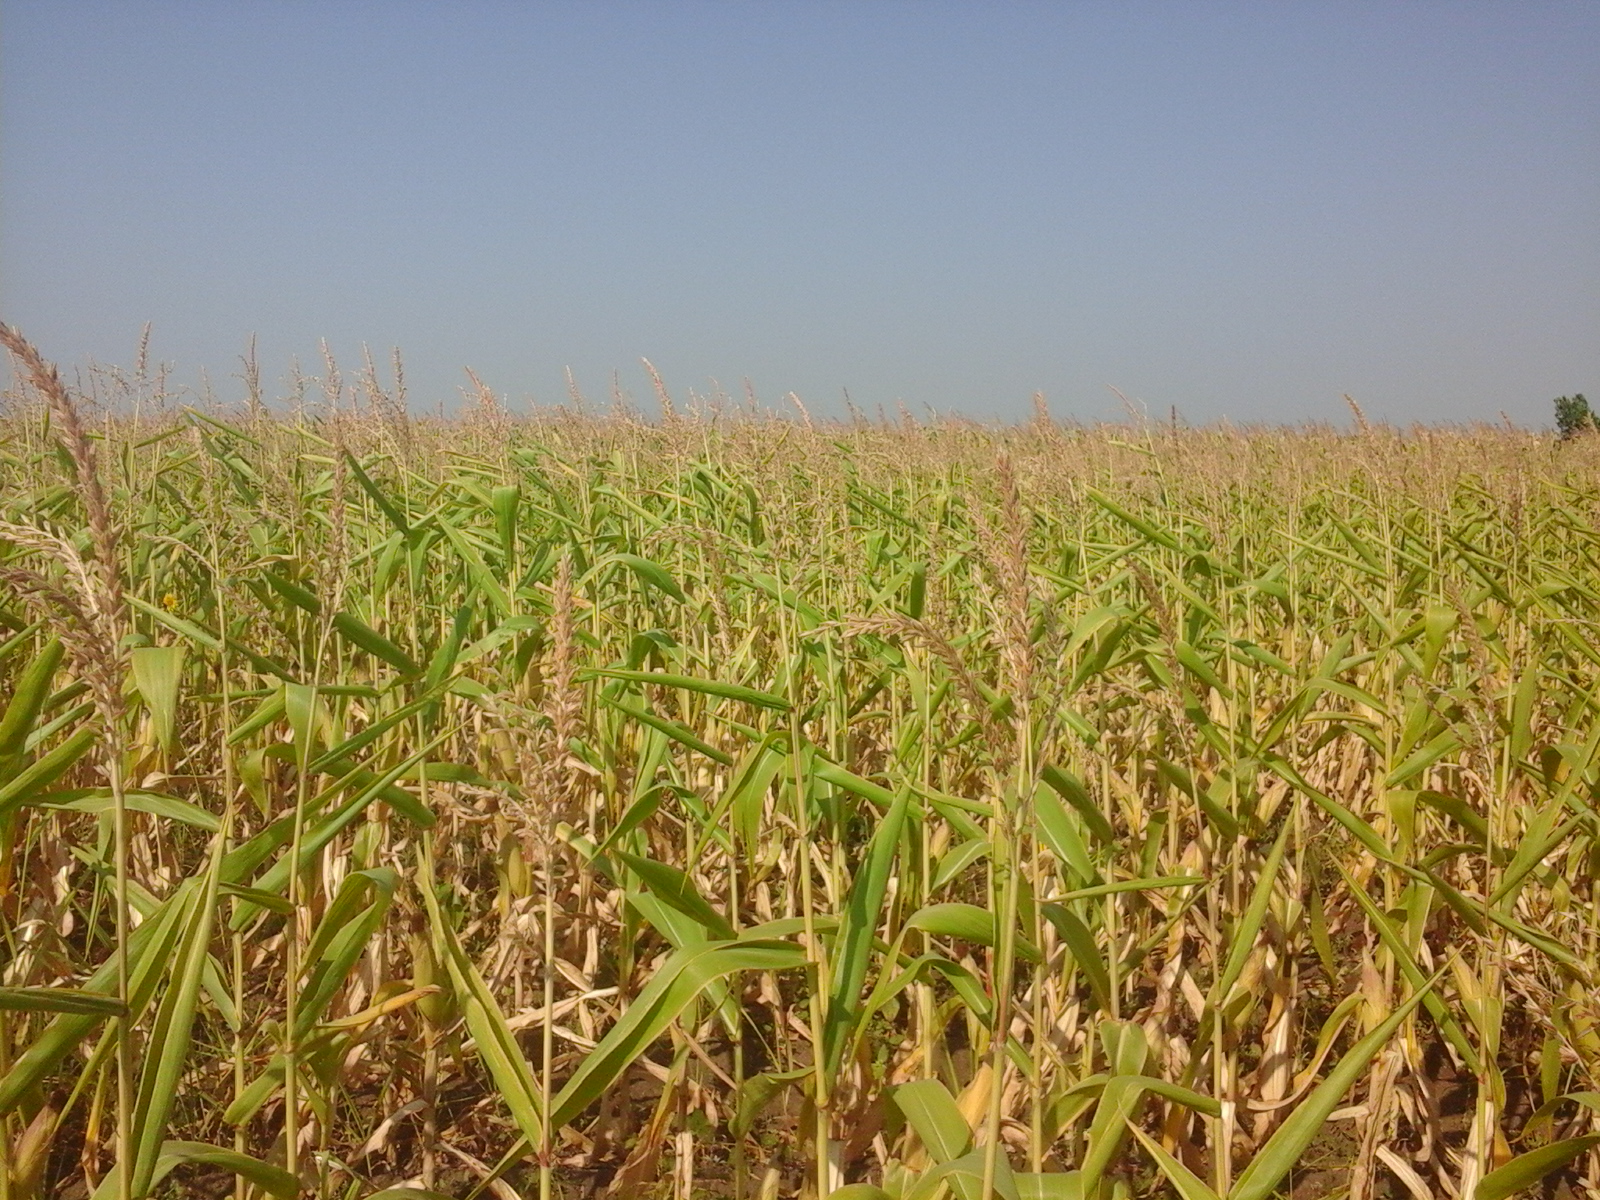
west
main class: Cropland
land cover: Maize
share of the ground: > 75 %
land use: Agriculture (excluding fallow land and kitchen gardens)
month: August
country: RO
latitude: 45.7557
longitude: 27.6313
